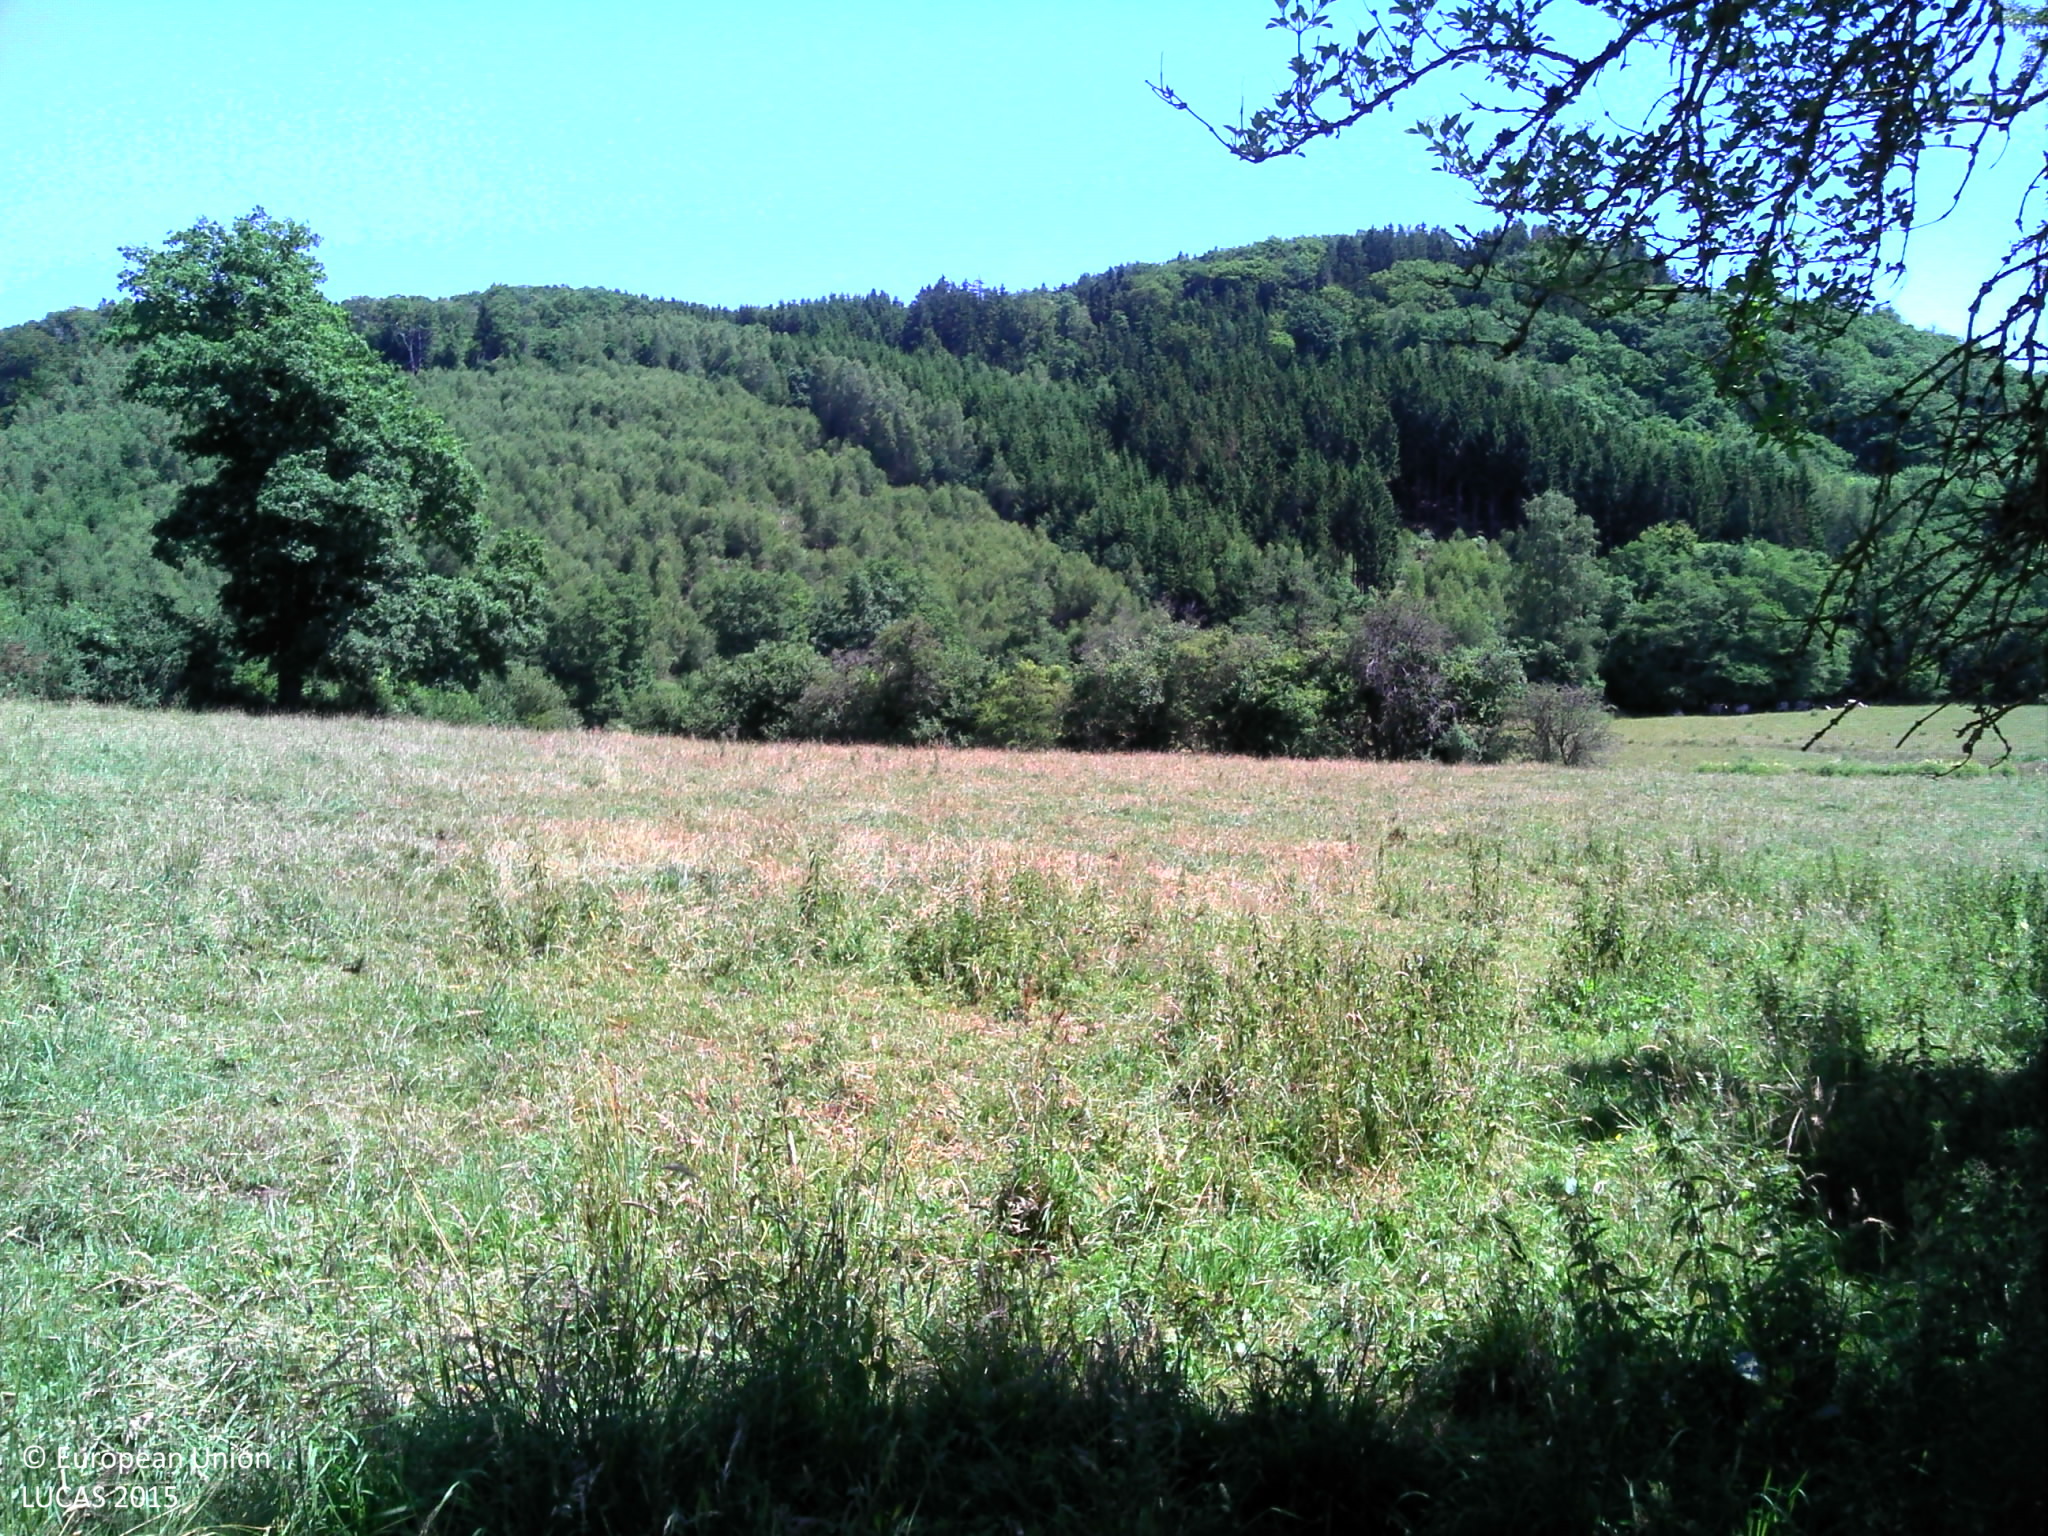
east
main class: Grassland
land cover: Grassland without tree/shrub cover
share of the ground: > 75 %
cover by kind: herbaceous plants 100 %
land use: Agriculture (excluding fallow land and kitchen gardens)
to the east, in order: Grassland without tree/shrub cover; Abandoned hedges; Grassland without tree/shrub cover; Fences; Spontaneously vegetated surfaces; Abandoned hedges; Rivers and streams; Shrubland without tree cover; Broadleaved woodland; Tracks; Broadleaved woodland
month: July
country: BE
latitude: 50.0823
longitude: 5.6243
